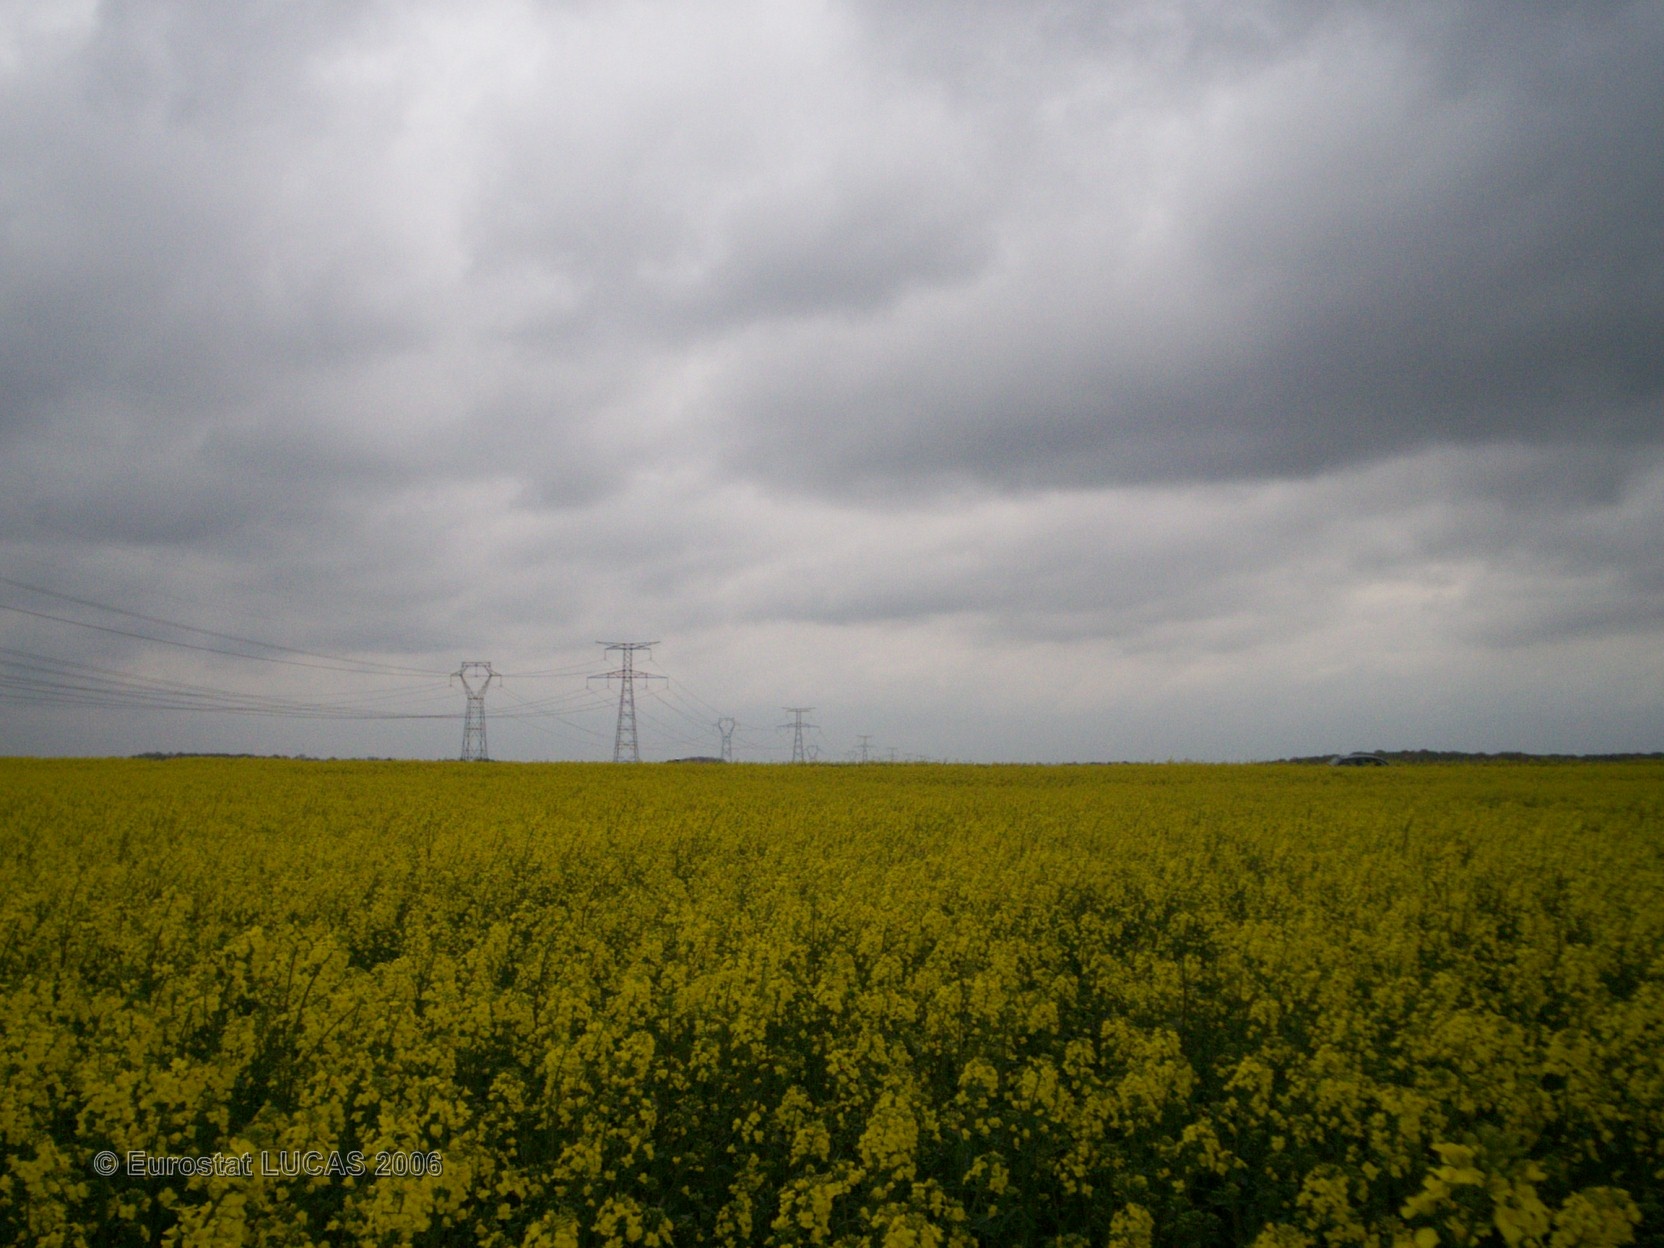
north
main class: Cropland
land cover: Rape and turnip rape
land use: Agriculture (excluding fallow land and kitchen gardens)
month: May
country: FR
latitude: 48.1541
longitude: 2.8539
